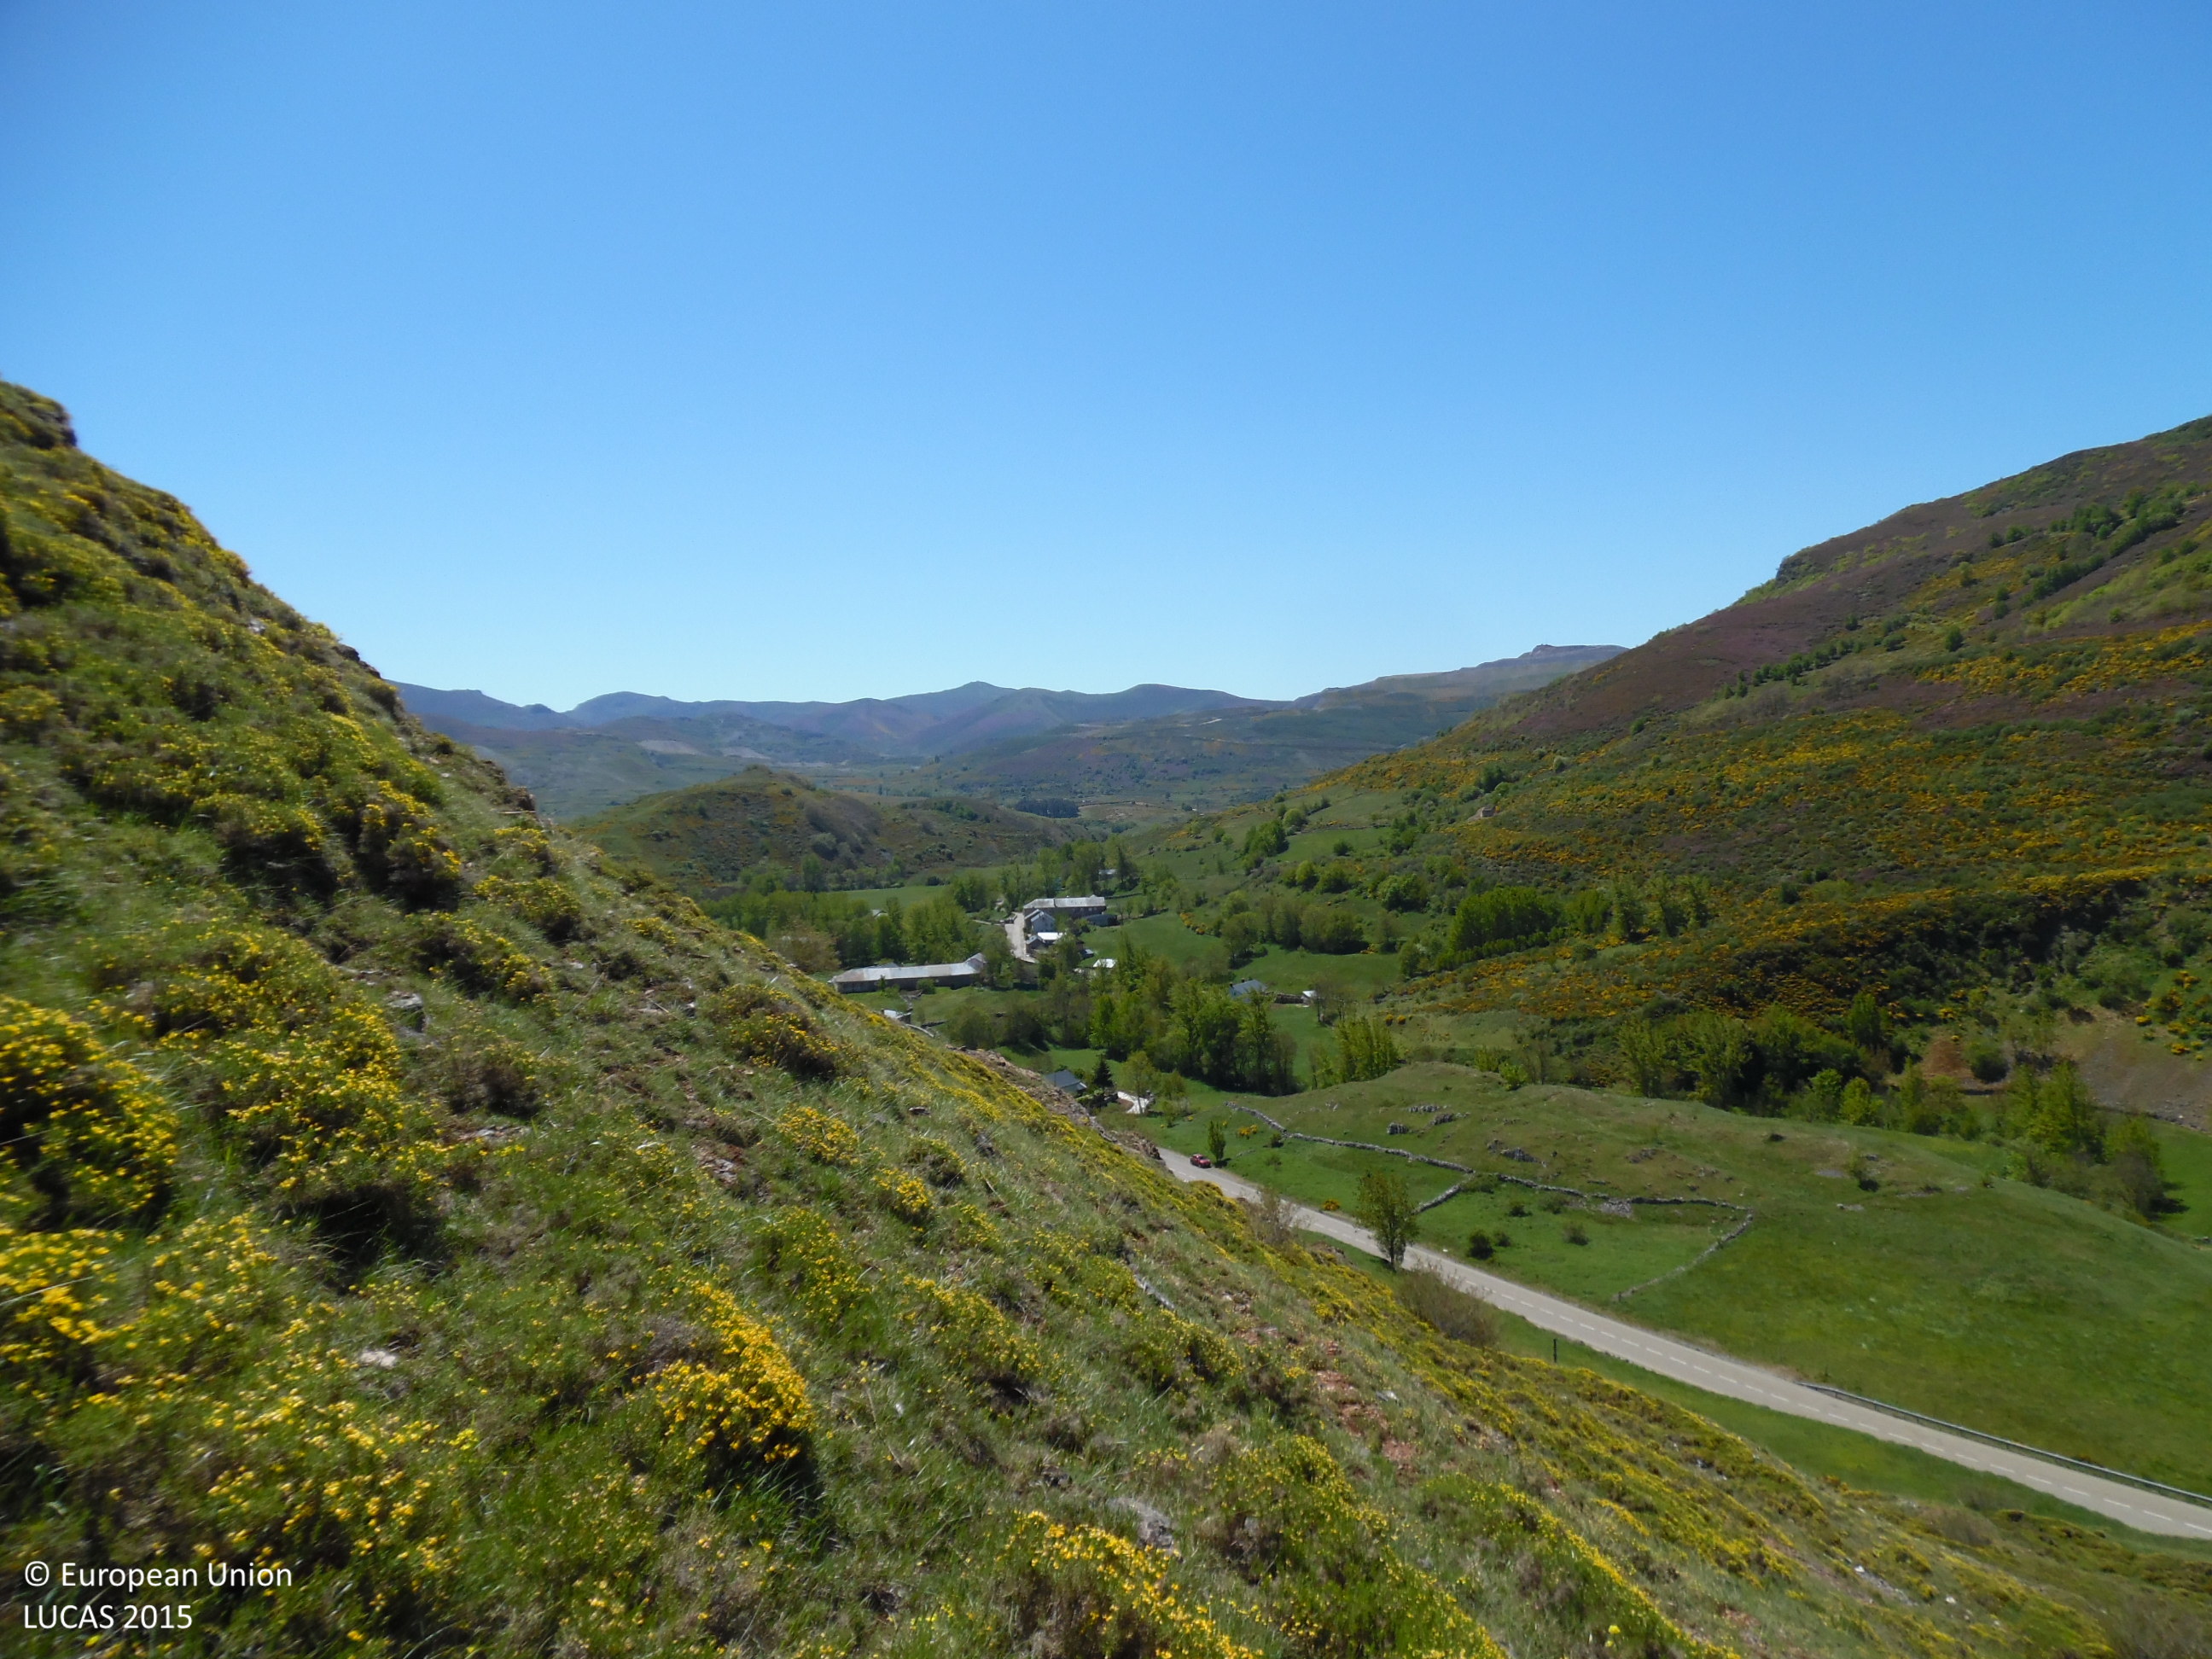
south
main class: Shrubland
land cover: Shrubland without tree cover
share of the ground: > 75 %
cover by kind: shrubs 90 %, herbaceous plants 10 %
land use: Semi-natural and natural areas not in use
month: May
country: ES
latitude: 42.9730
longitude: -6.2152
